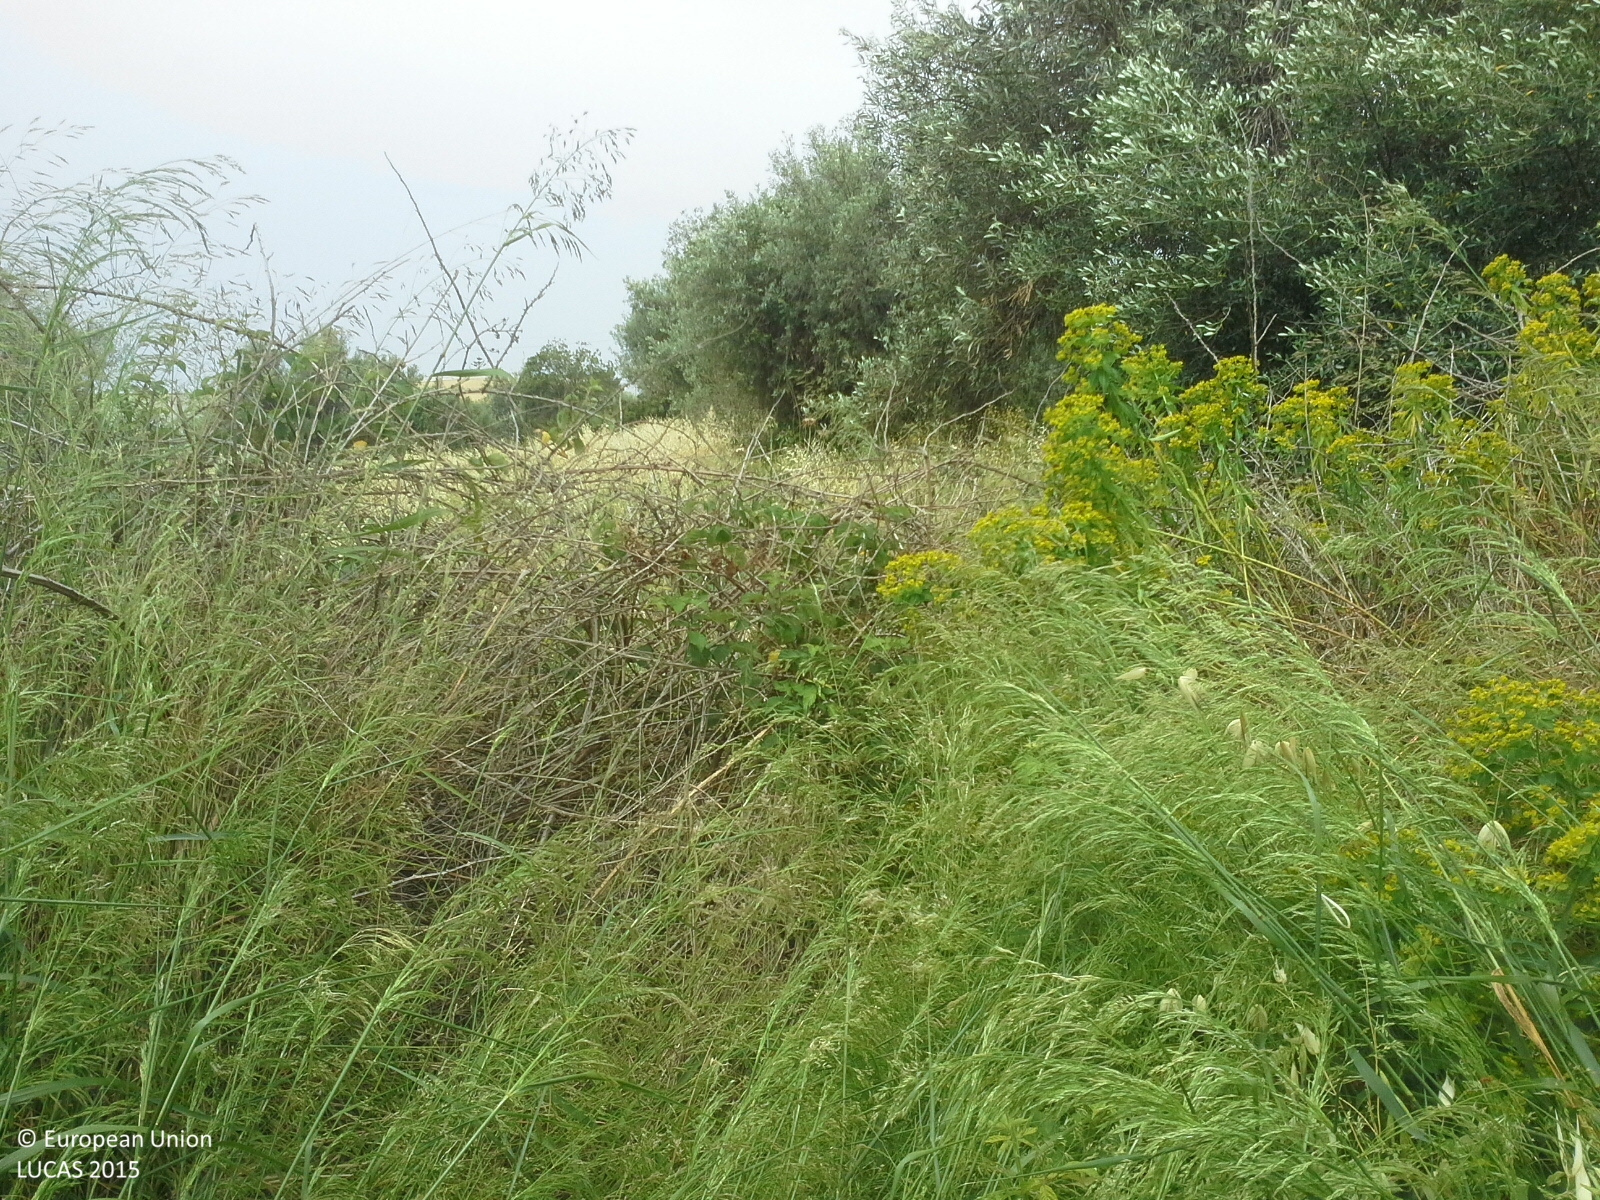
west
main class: Cropland
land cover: Mixed cereals for fodder
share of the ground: > 75 %
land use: Agriculture (excluding fallow land and kitchen gardens)
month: May
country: IT
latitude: 36.8081
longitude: 14.7925
